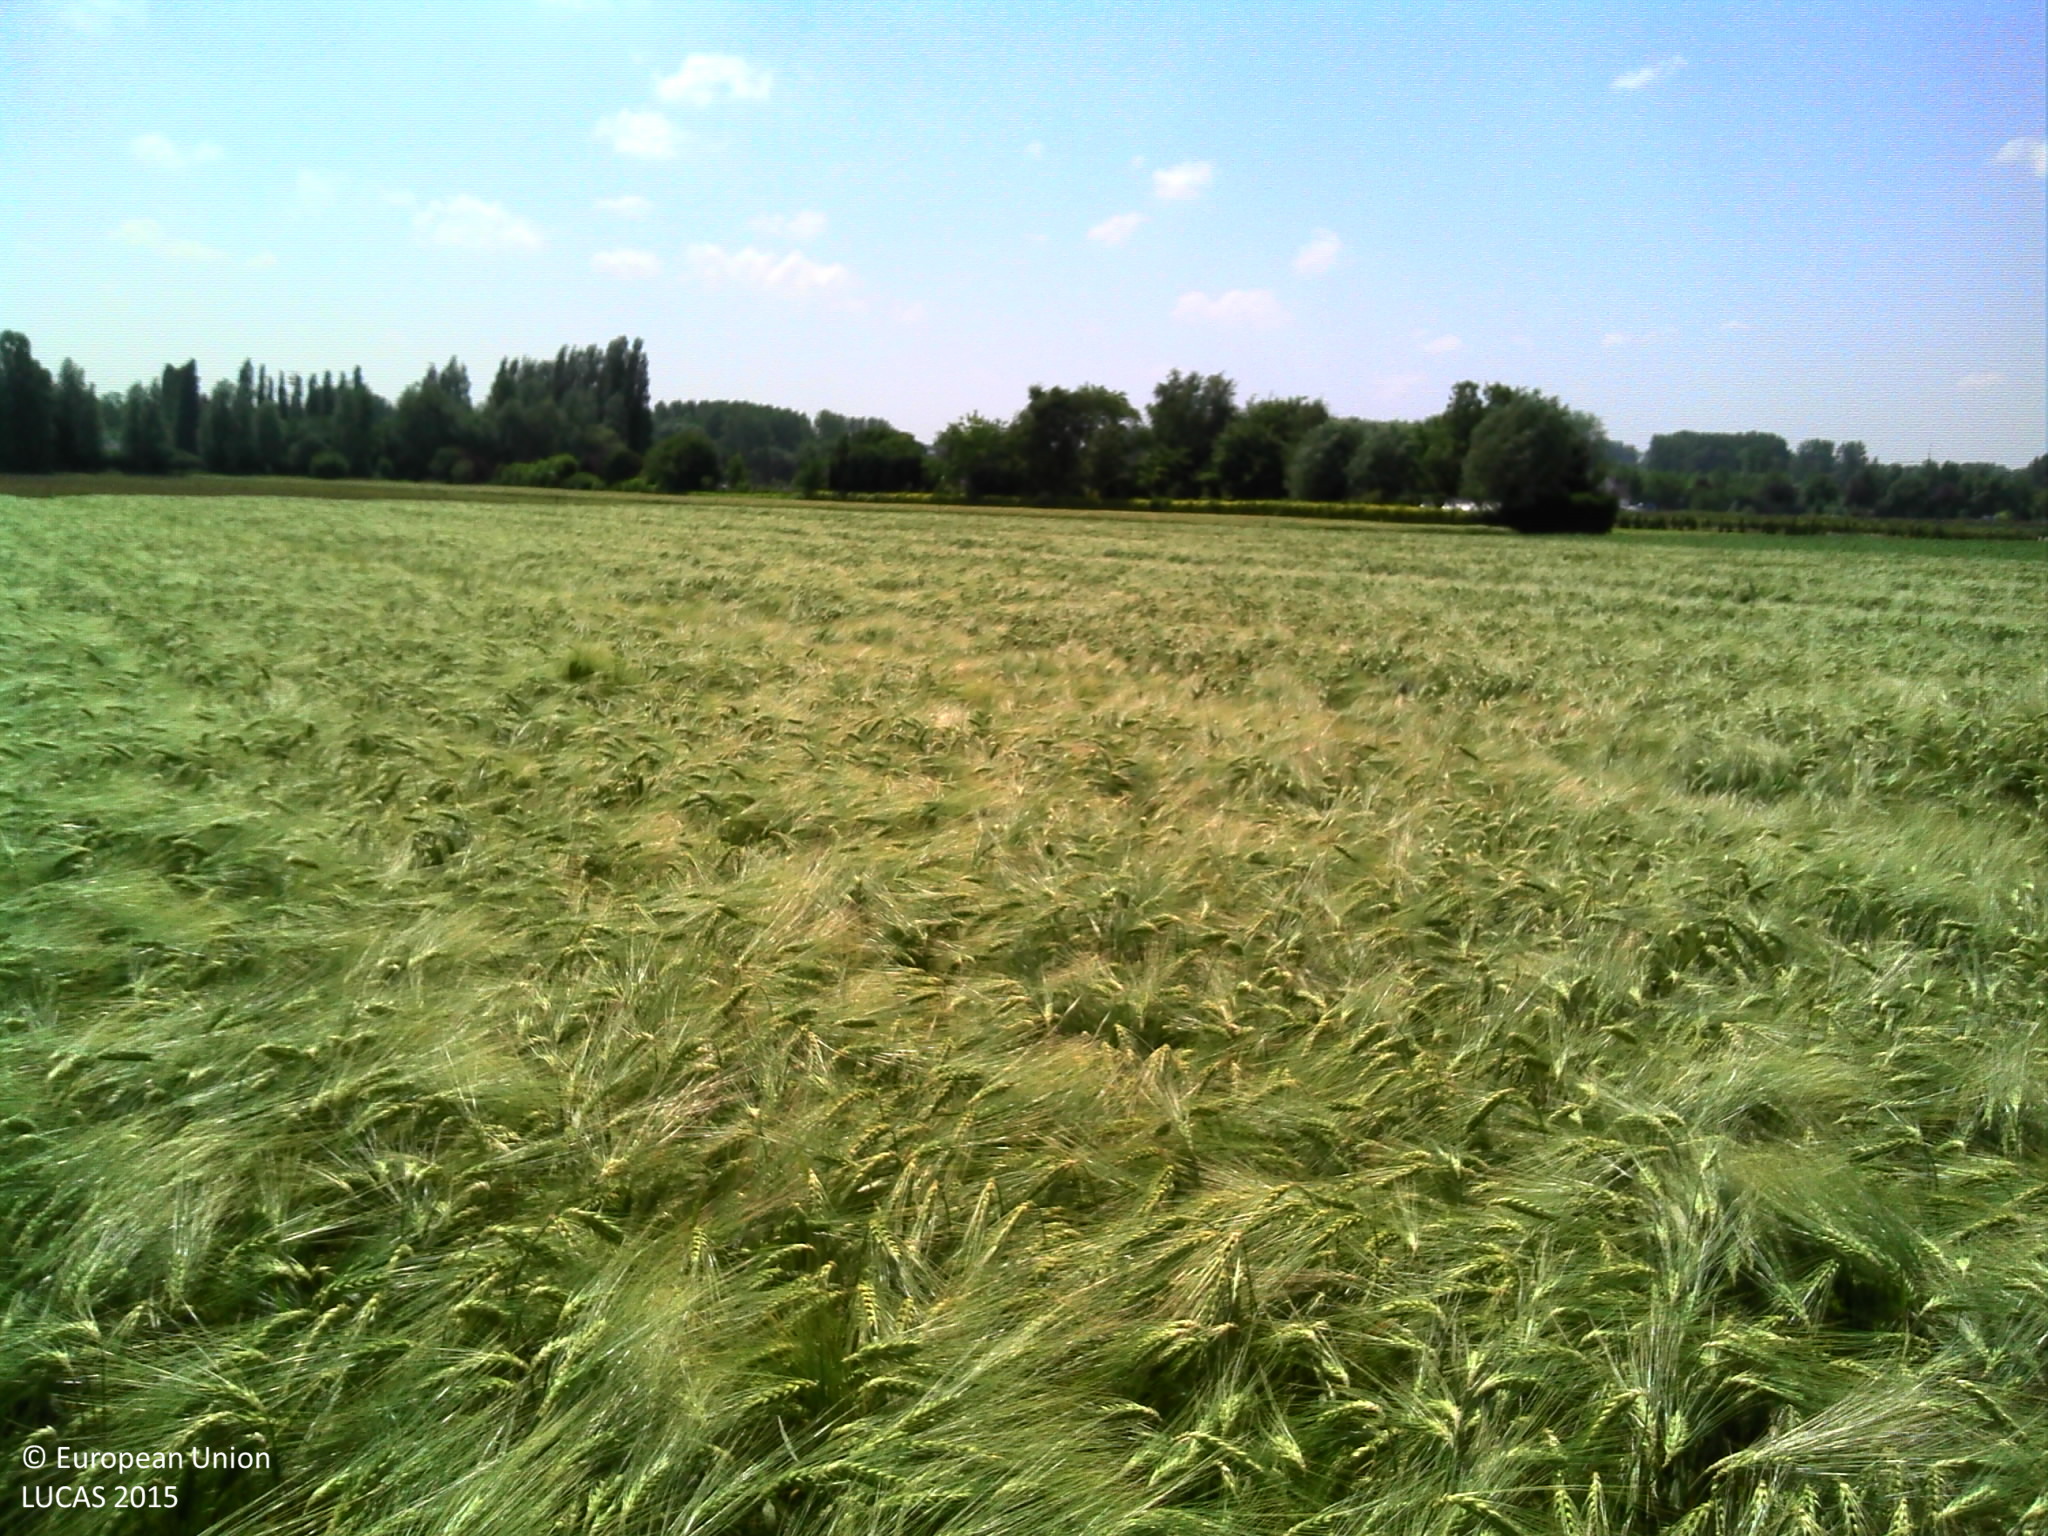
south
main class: Cropland
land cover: Barley
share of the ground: > 75 %
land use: Agriculture (excluding fallow land and kitchen gardens)
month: June
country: BE
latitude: 50.9594
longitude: 3.9145
